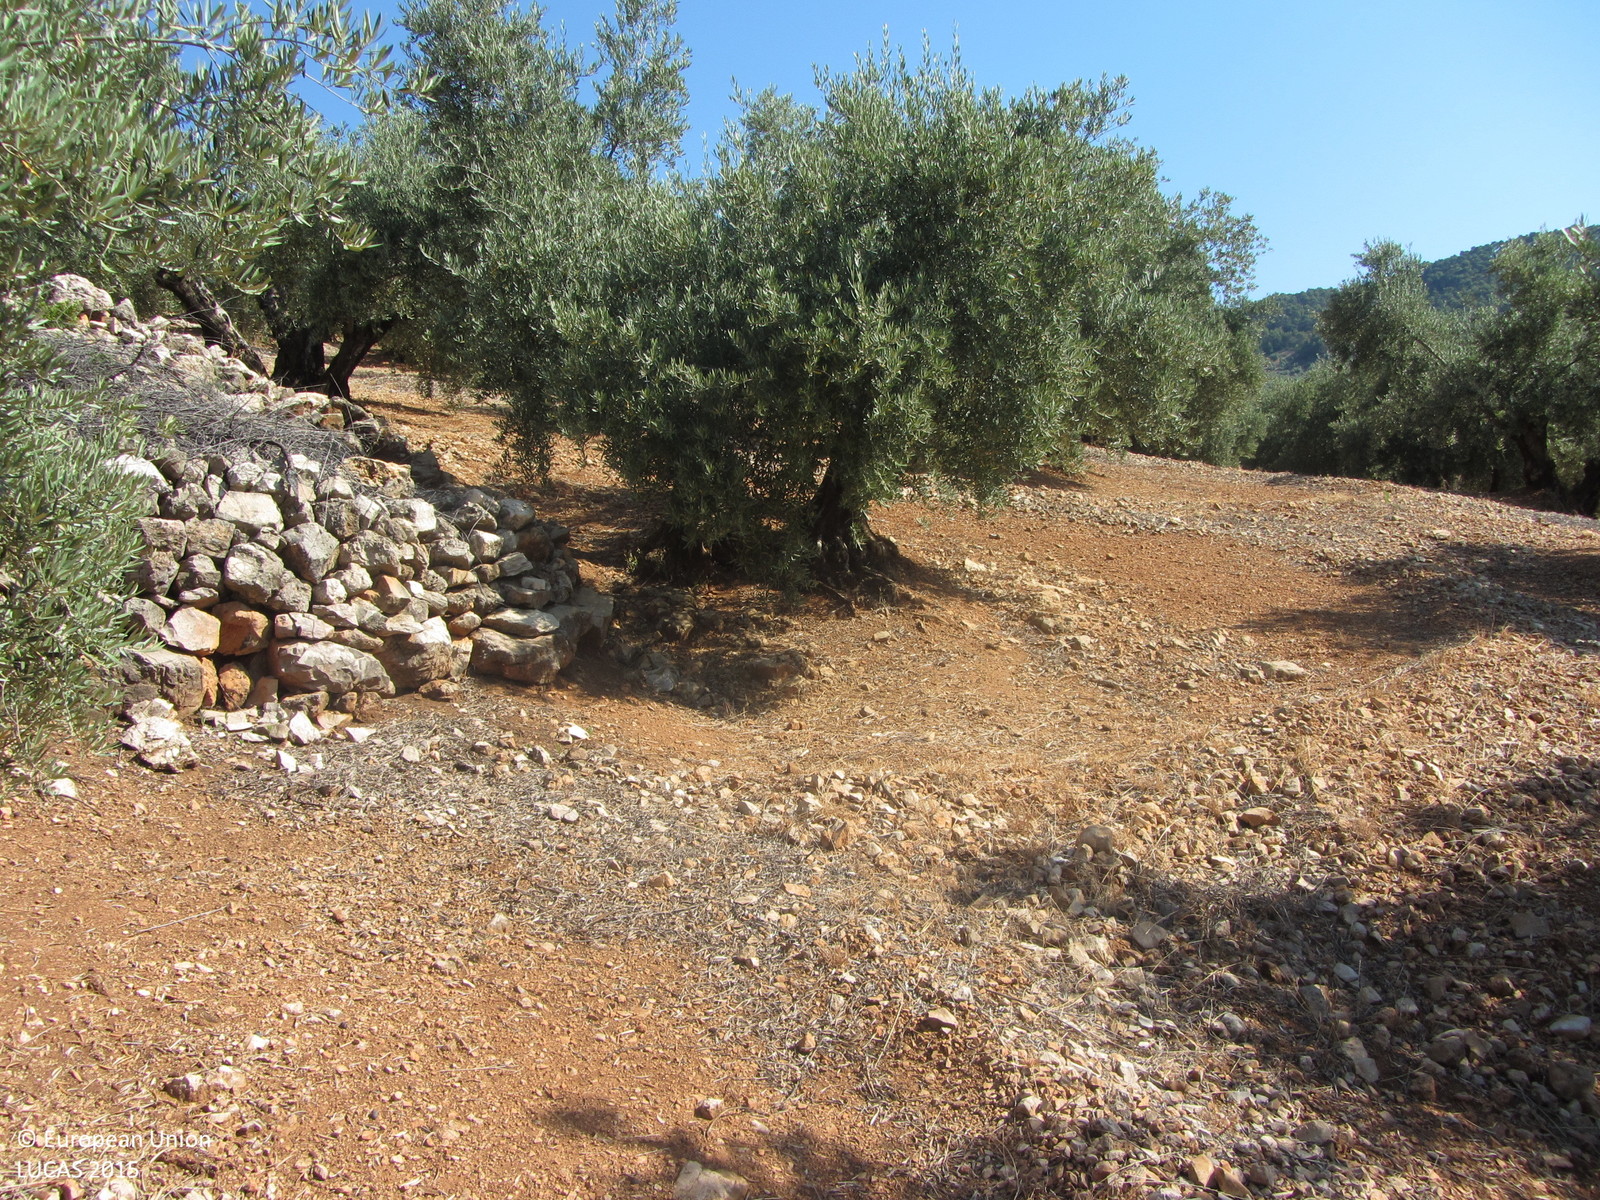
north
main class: Cropland
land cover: Olive groves
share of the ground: 25 - 50 %
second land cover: Other bare soil
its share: > 75 %
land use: Agriculture (excluding fallow land and kitchen gardens)
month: June
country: ES
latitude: 38.2014
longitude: -2.9137
